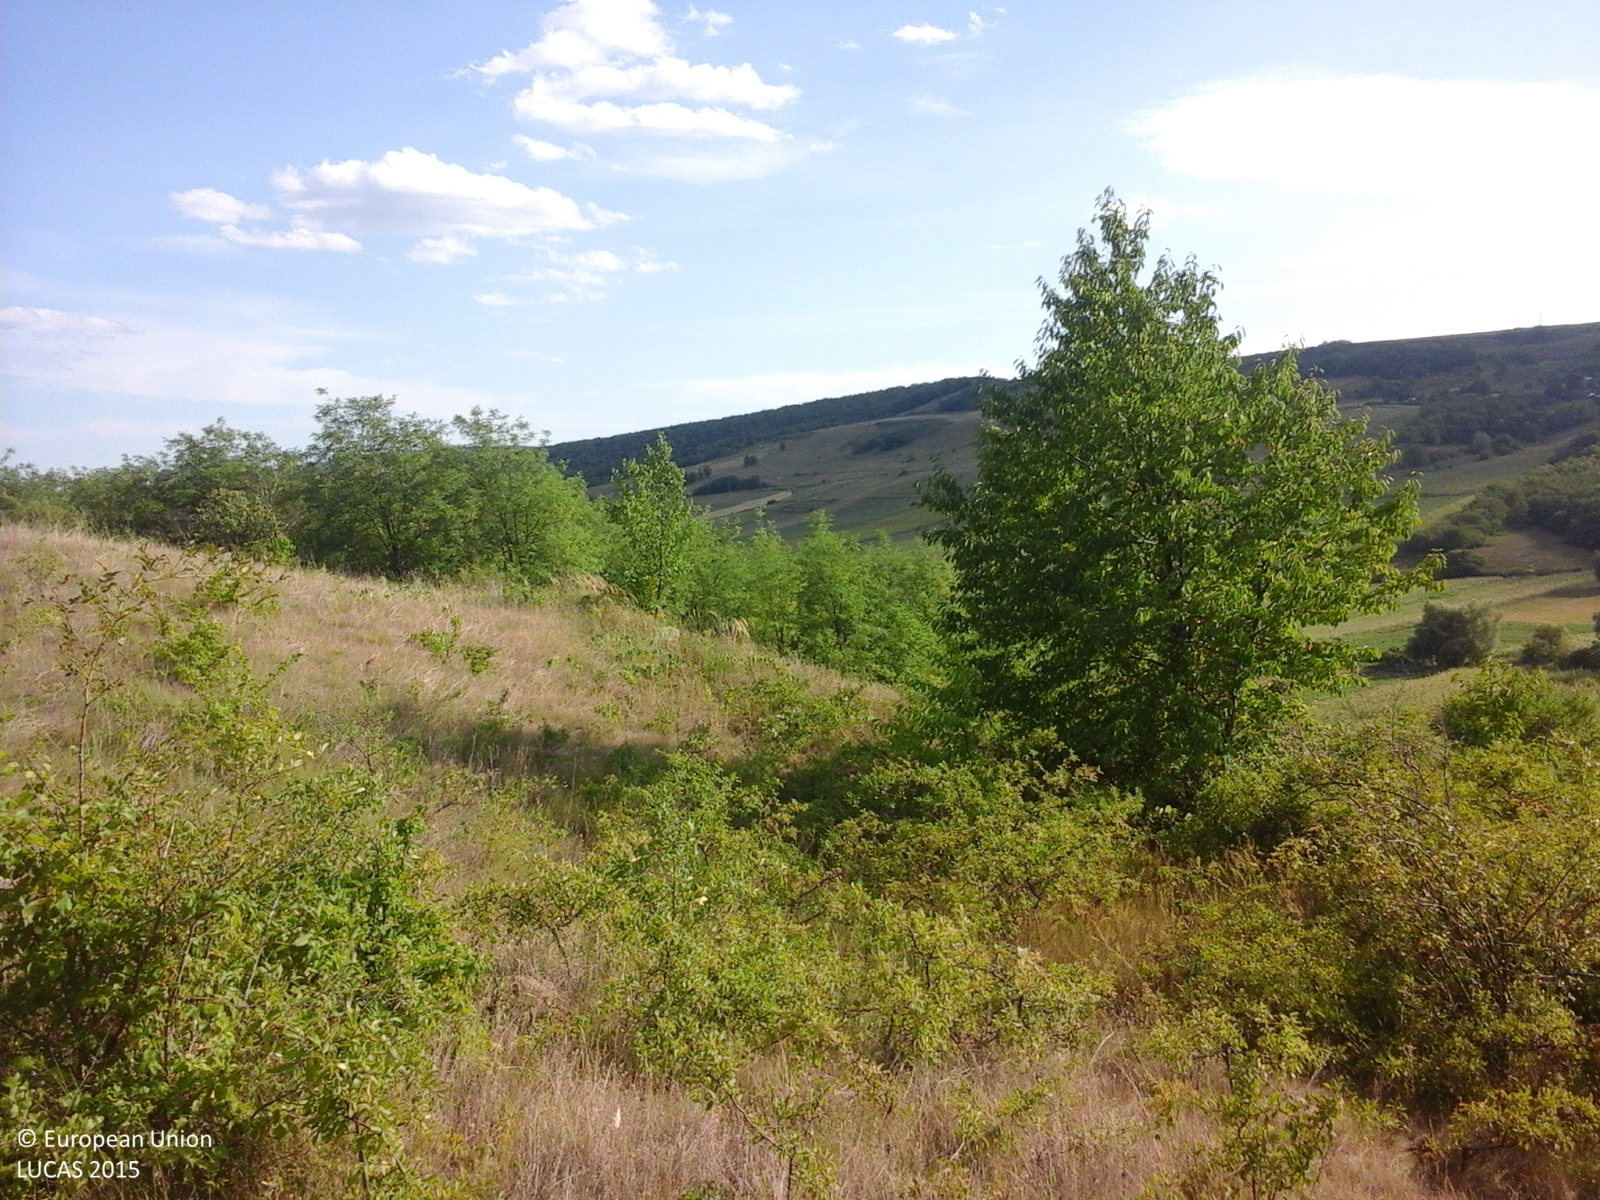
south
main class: Grassland
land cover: Grassland with sparse tree/shrub cover
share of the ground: > 75 %
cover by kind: herbaceous plants 85 %, shrubs 10 %, broadleaved forest trees 5 %
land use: Fallow land
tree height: < 5 m
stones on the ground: < 10 %
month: July
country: RO
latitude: 46.3333
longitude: 27.3700
